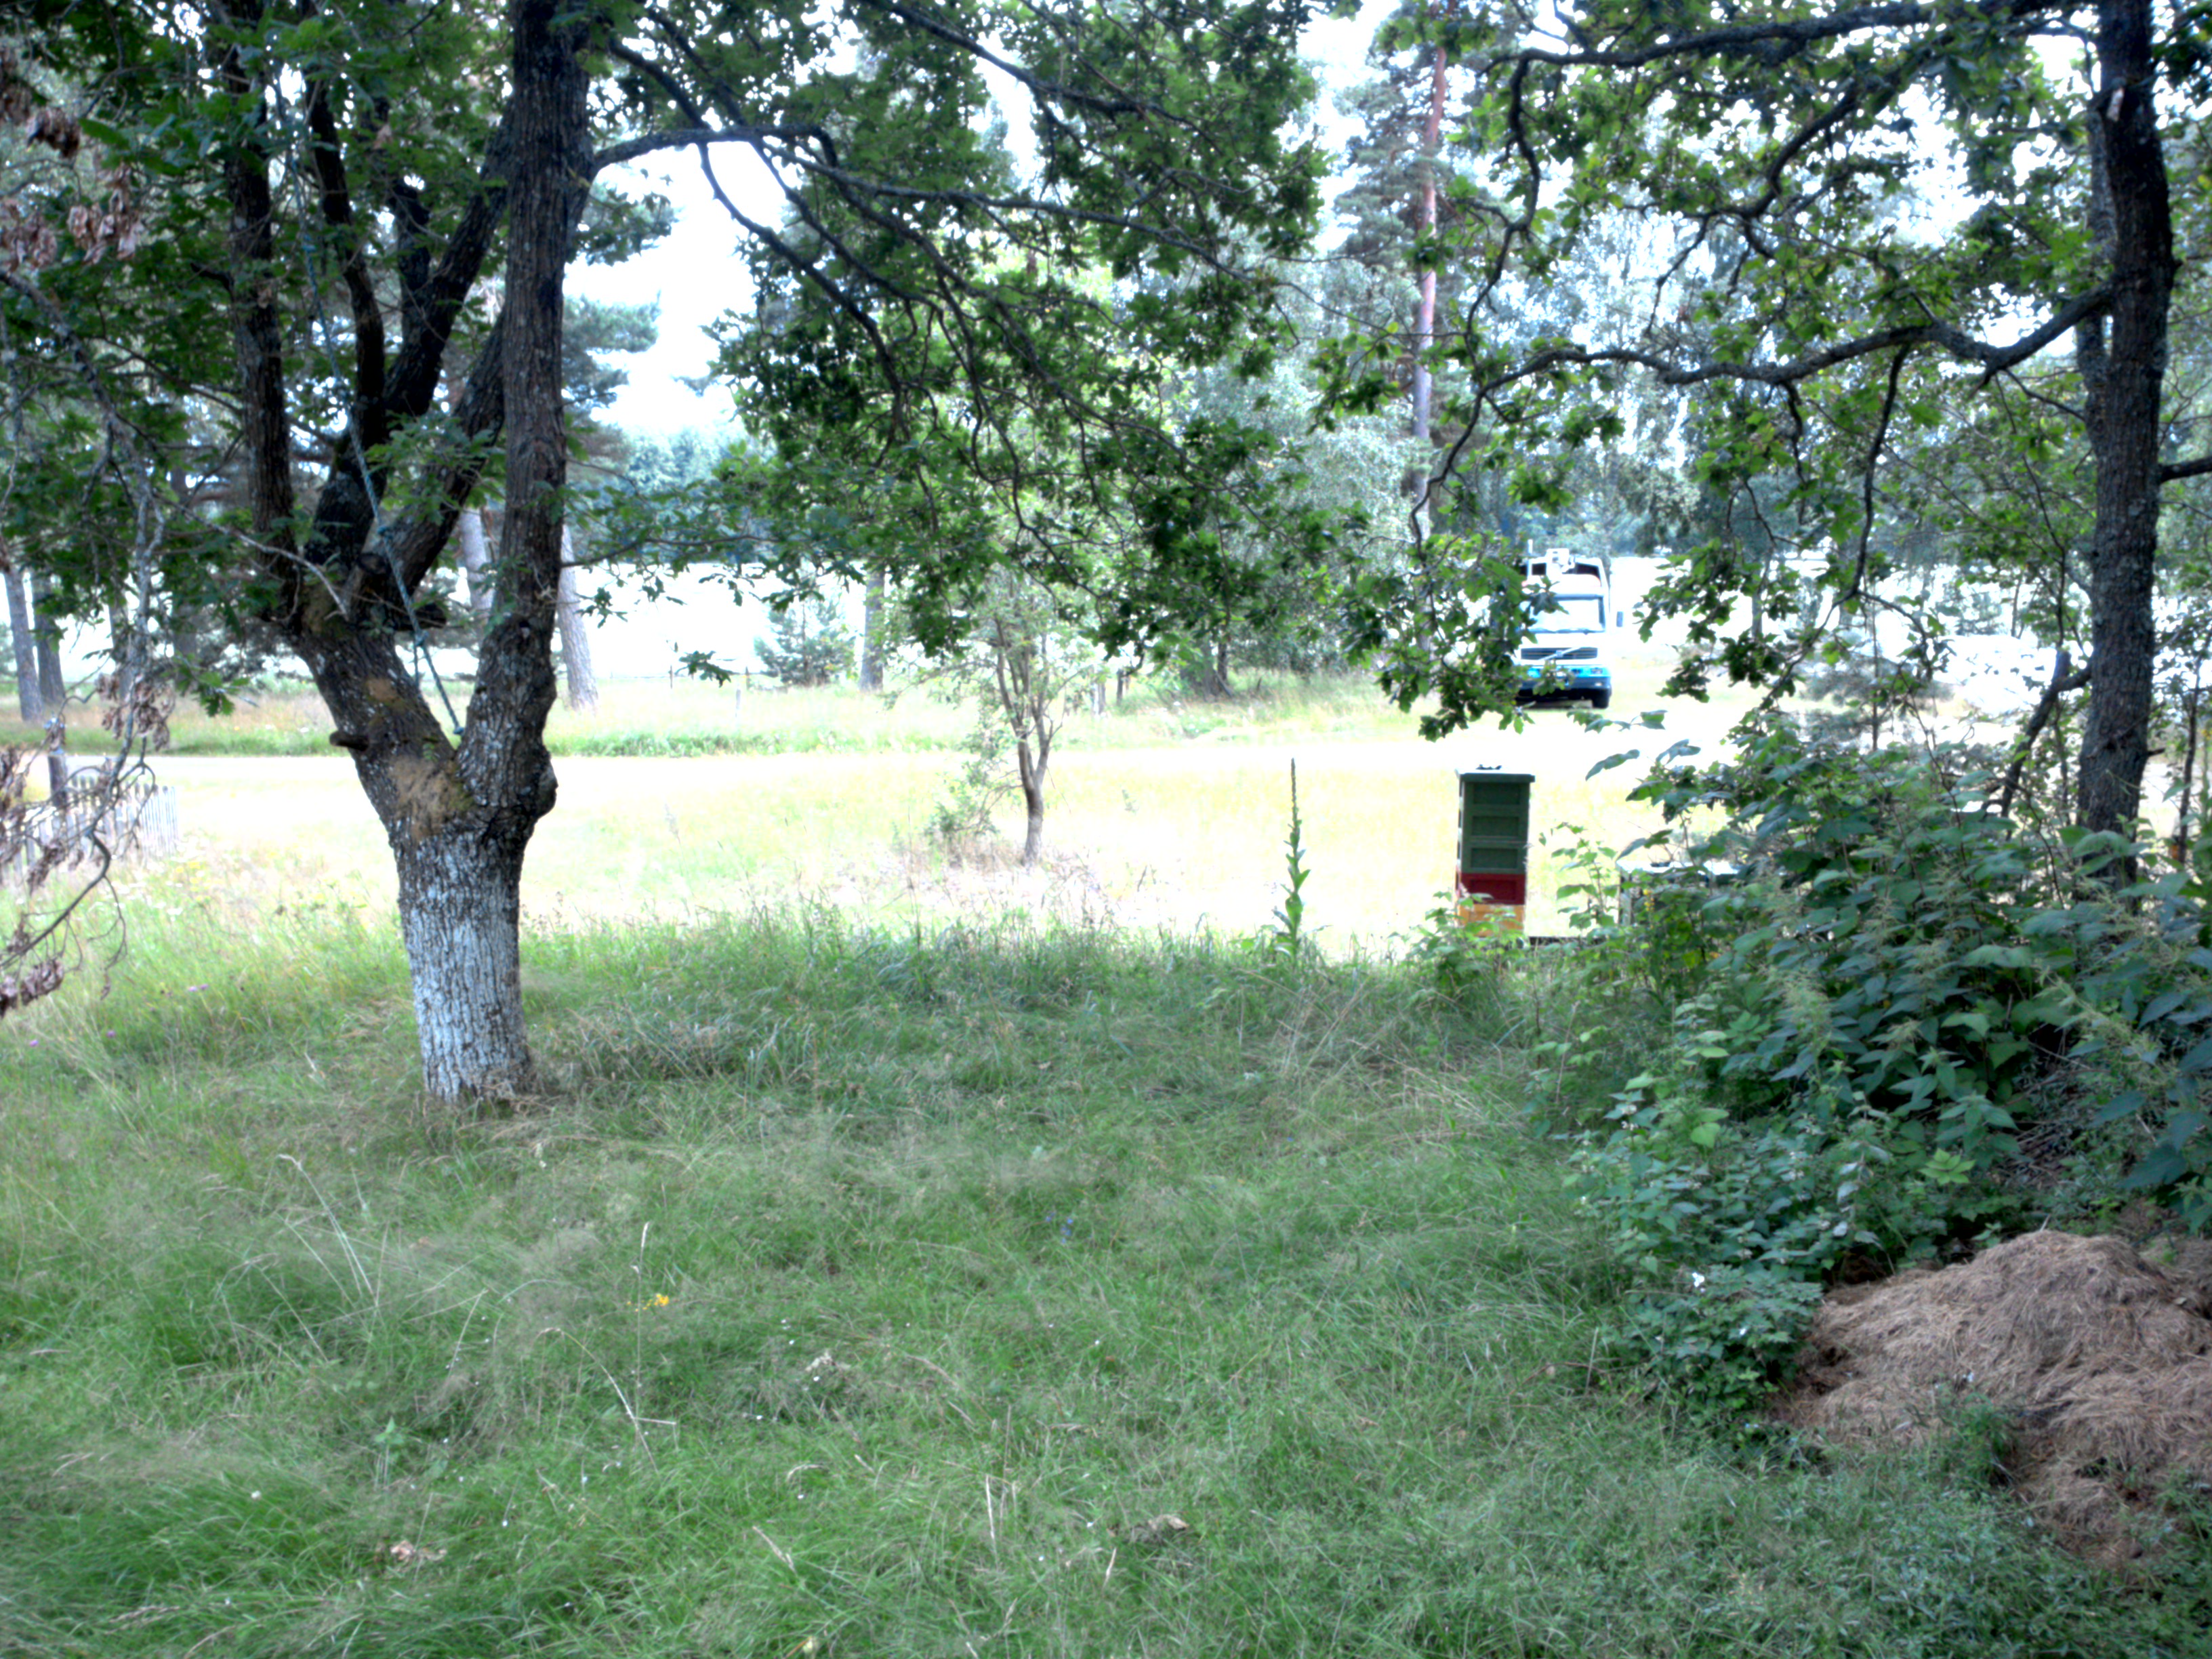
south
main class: Woodland
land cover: Broadleaved woodland
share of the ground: 50 - 75 %
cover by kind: broadleaved forest trees 55 %, herbaceous plants 35 %, coniferous forest trees 10 %
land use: Residential
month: July
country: SE
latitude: 59.1347
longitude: 18.3720
